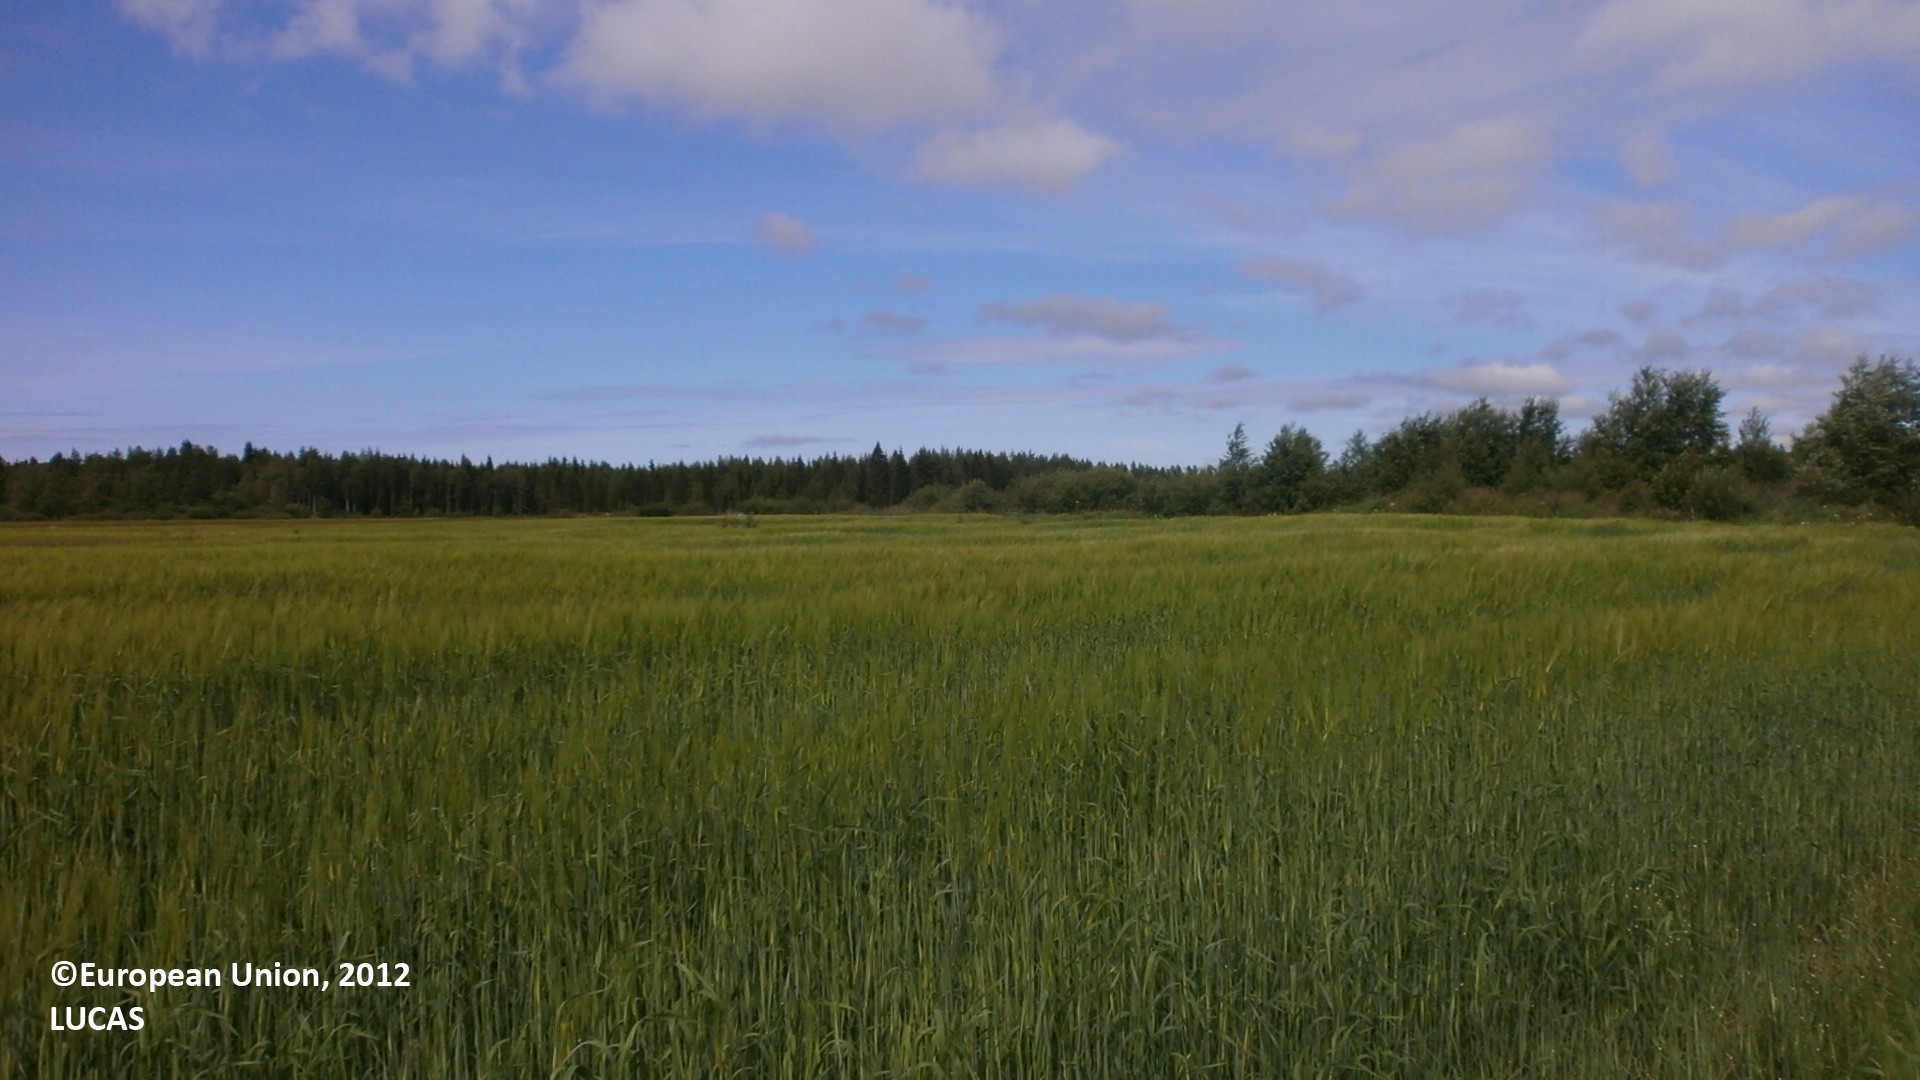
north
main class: Cropland
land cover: Barley
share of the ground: > 75 %
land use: Agriculture (excluding fallow land and kitchen gardens)
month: July
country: FI
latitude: 64.2249
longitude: 23.8915
